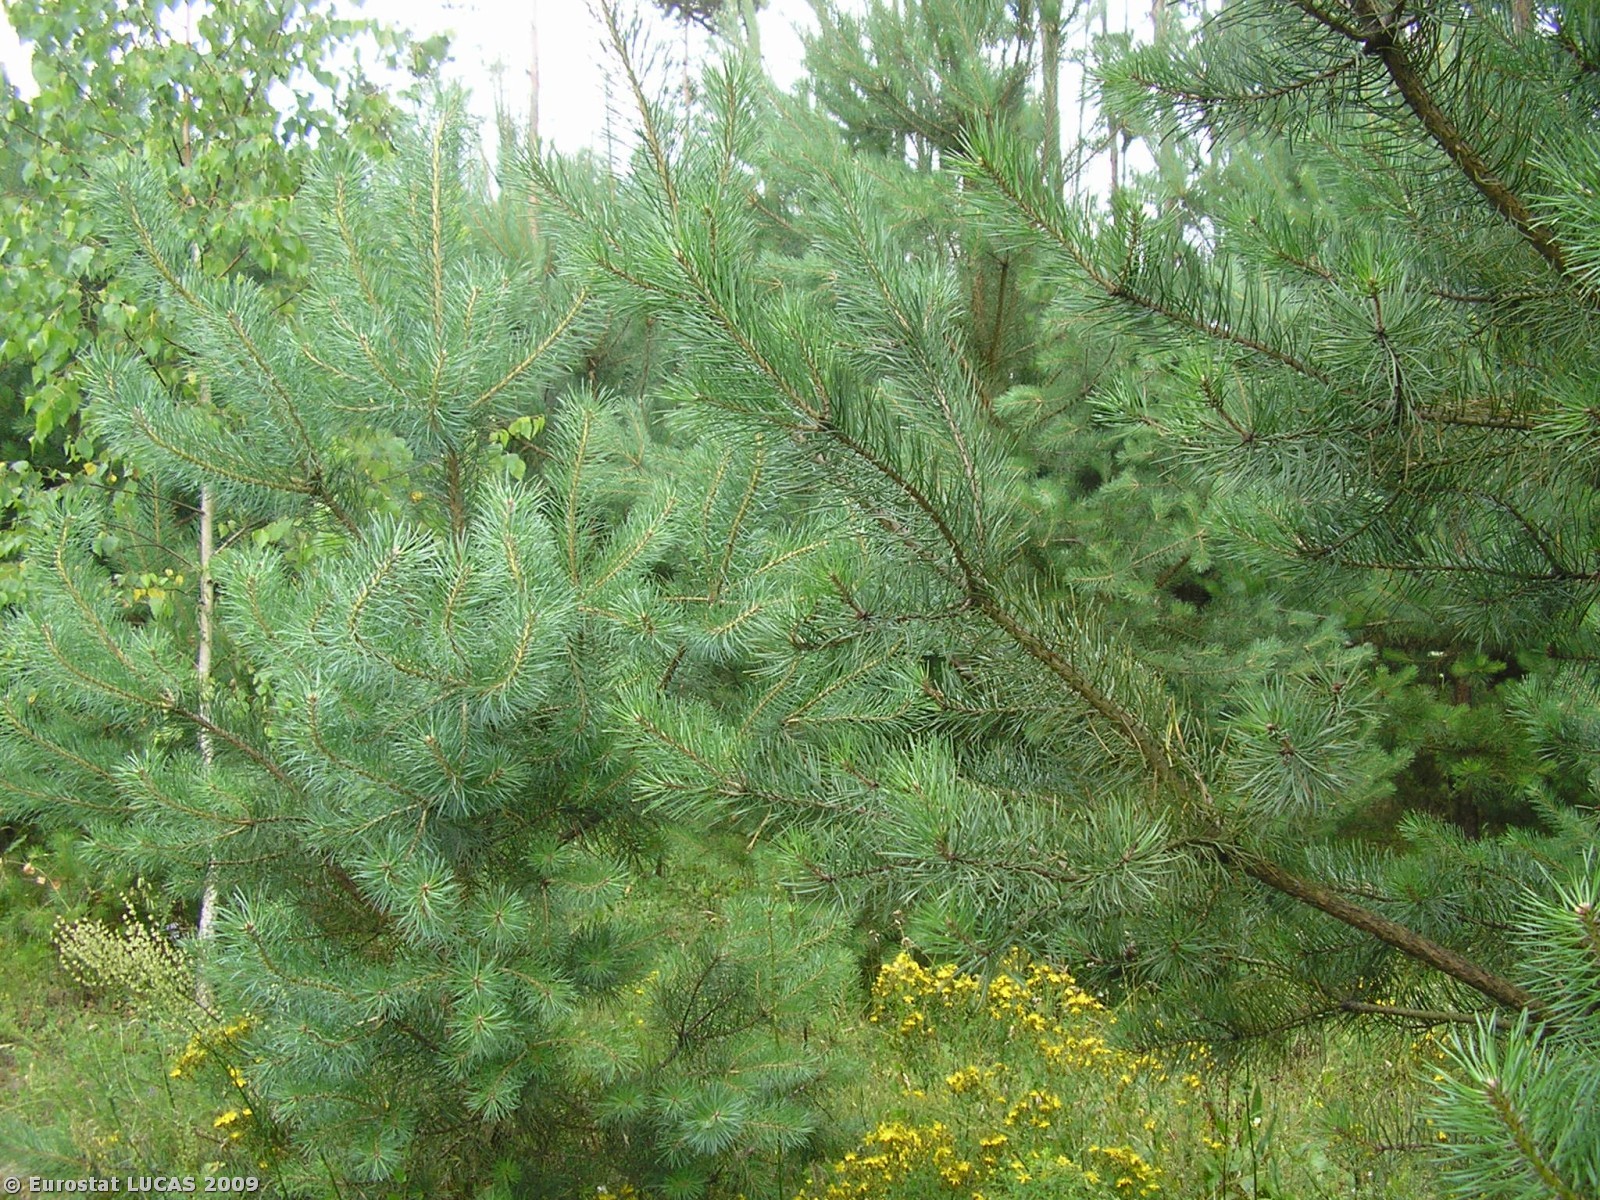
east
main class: Woodland
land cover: Coniferous woodland
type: hemiboreal forest and nemoral coniferous forest and mixed broadleaved-coniferous forest
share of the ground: > 75 %
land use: Forestry
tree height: > 5 m
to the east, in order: Coniferous woodland; Mixed woodland; Tracks; Mixed woodland; Electric lines; Mixed woodland
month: July
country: PL
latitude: 51.4865
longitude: 21.5294
